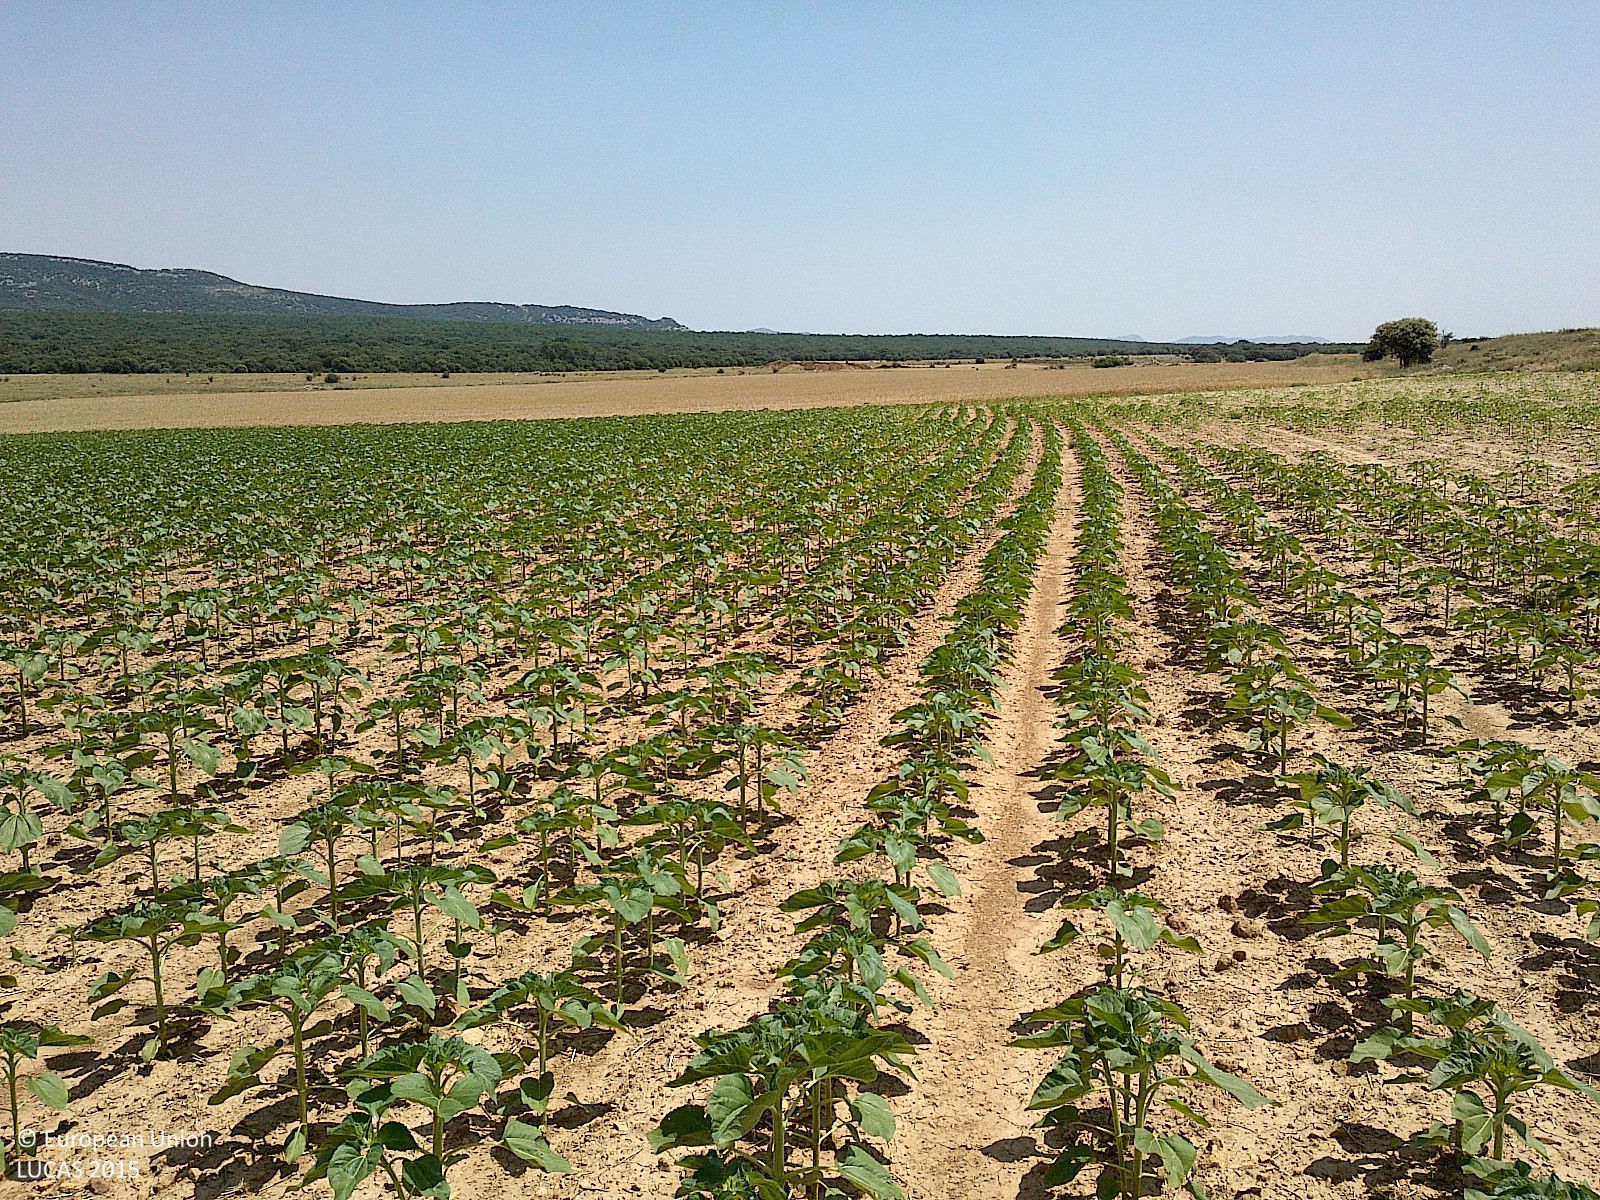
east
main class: Cropland
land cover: Sunflower
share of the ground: 10 - 25 %
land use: Agriculture (excluding fallow land and kitchen gardens)
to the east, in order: Sunflower; Common wheat
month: July
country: ES
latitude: 41.5894
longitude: -2.0153
